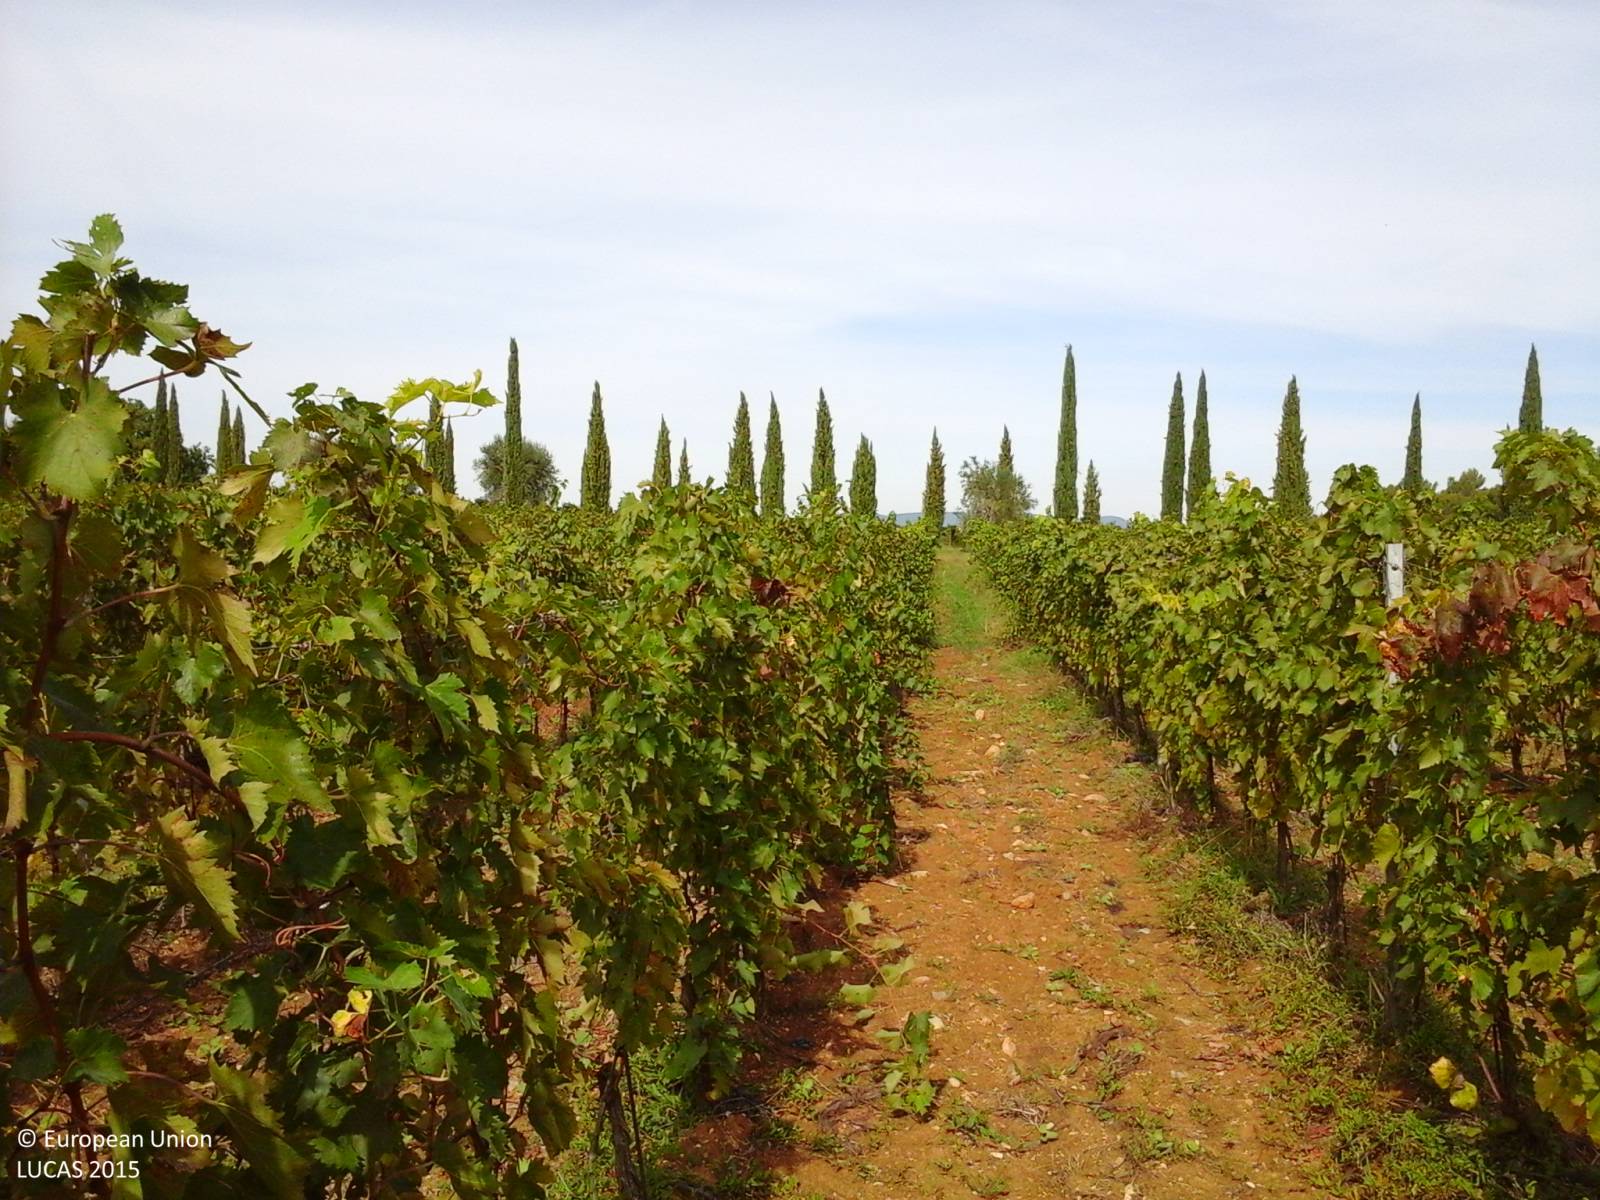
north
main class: Cropland
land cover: Vineyards
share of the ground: 50 - 75 %
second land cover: Other bare soil
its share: > 75 %
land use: Agriculture (excluding fallow land and kitchen gardens)
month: October
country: IT
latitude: 43.2481
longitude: 10.6017
